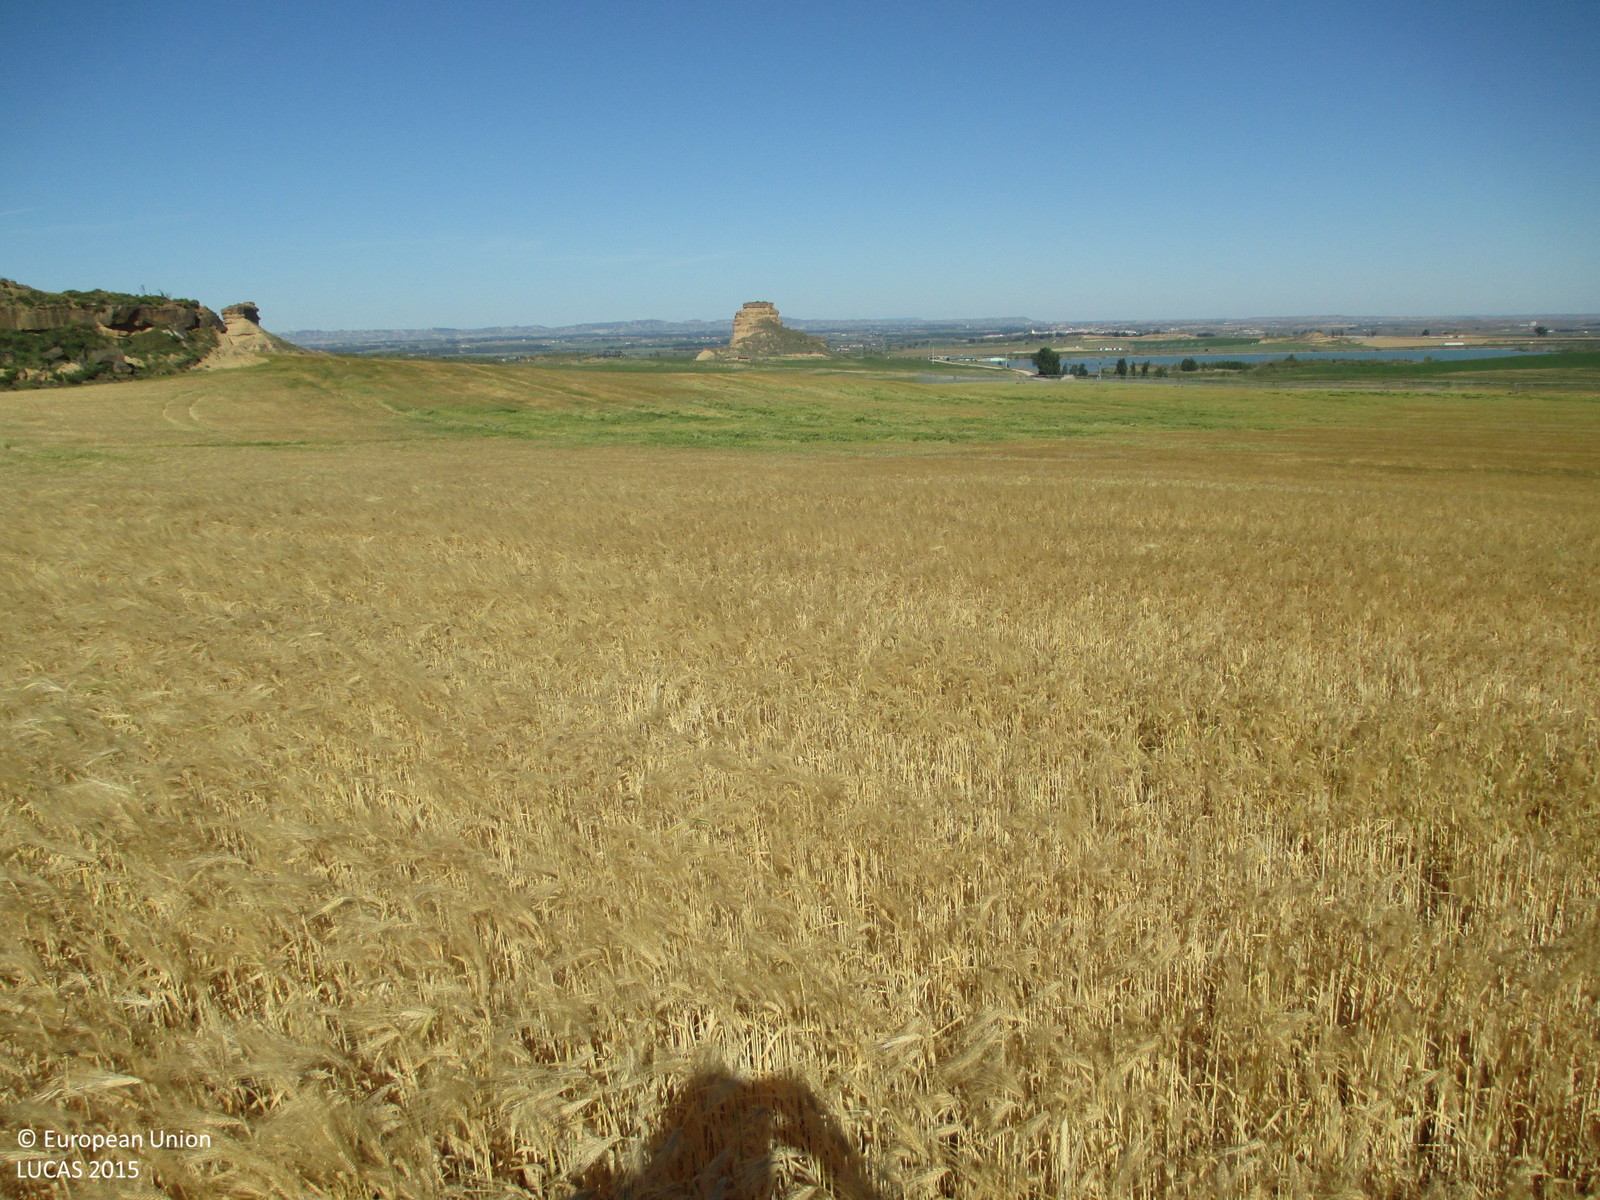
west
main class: Cropland
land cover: Barley
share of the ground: > 75 %
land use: Agriculture (excluding fallow land and kitchen gardens)
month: May
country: ES
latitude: 41.9138
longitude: -0.2556
